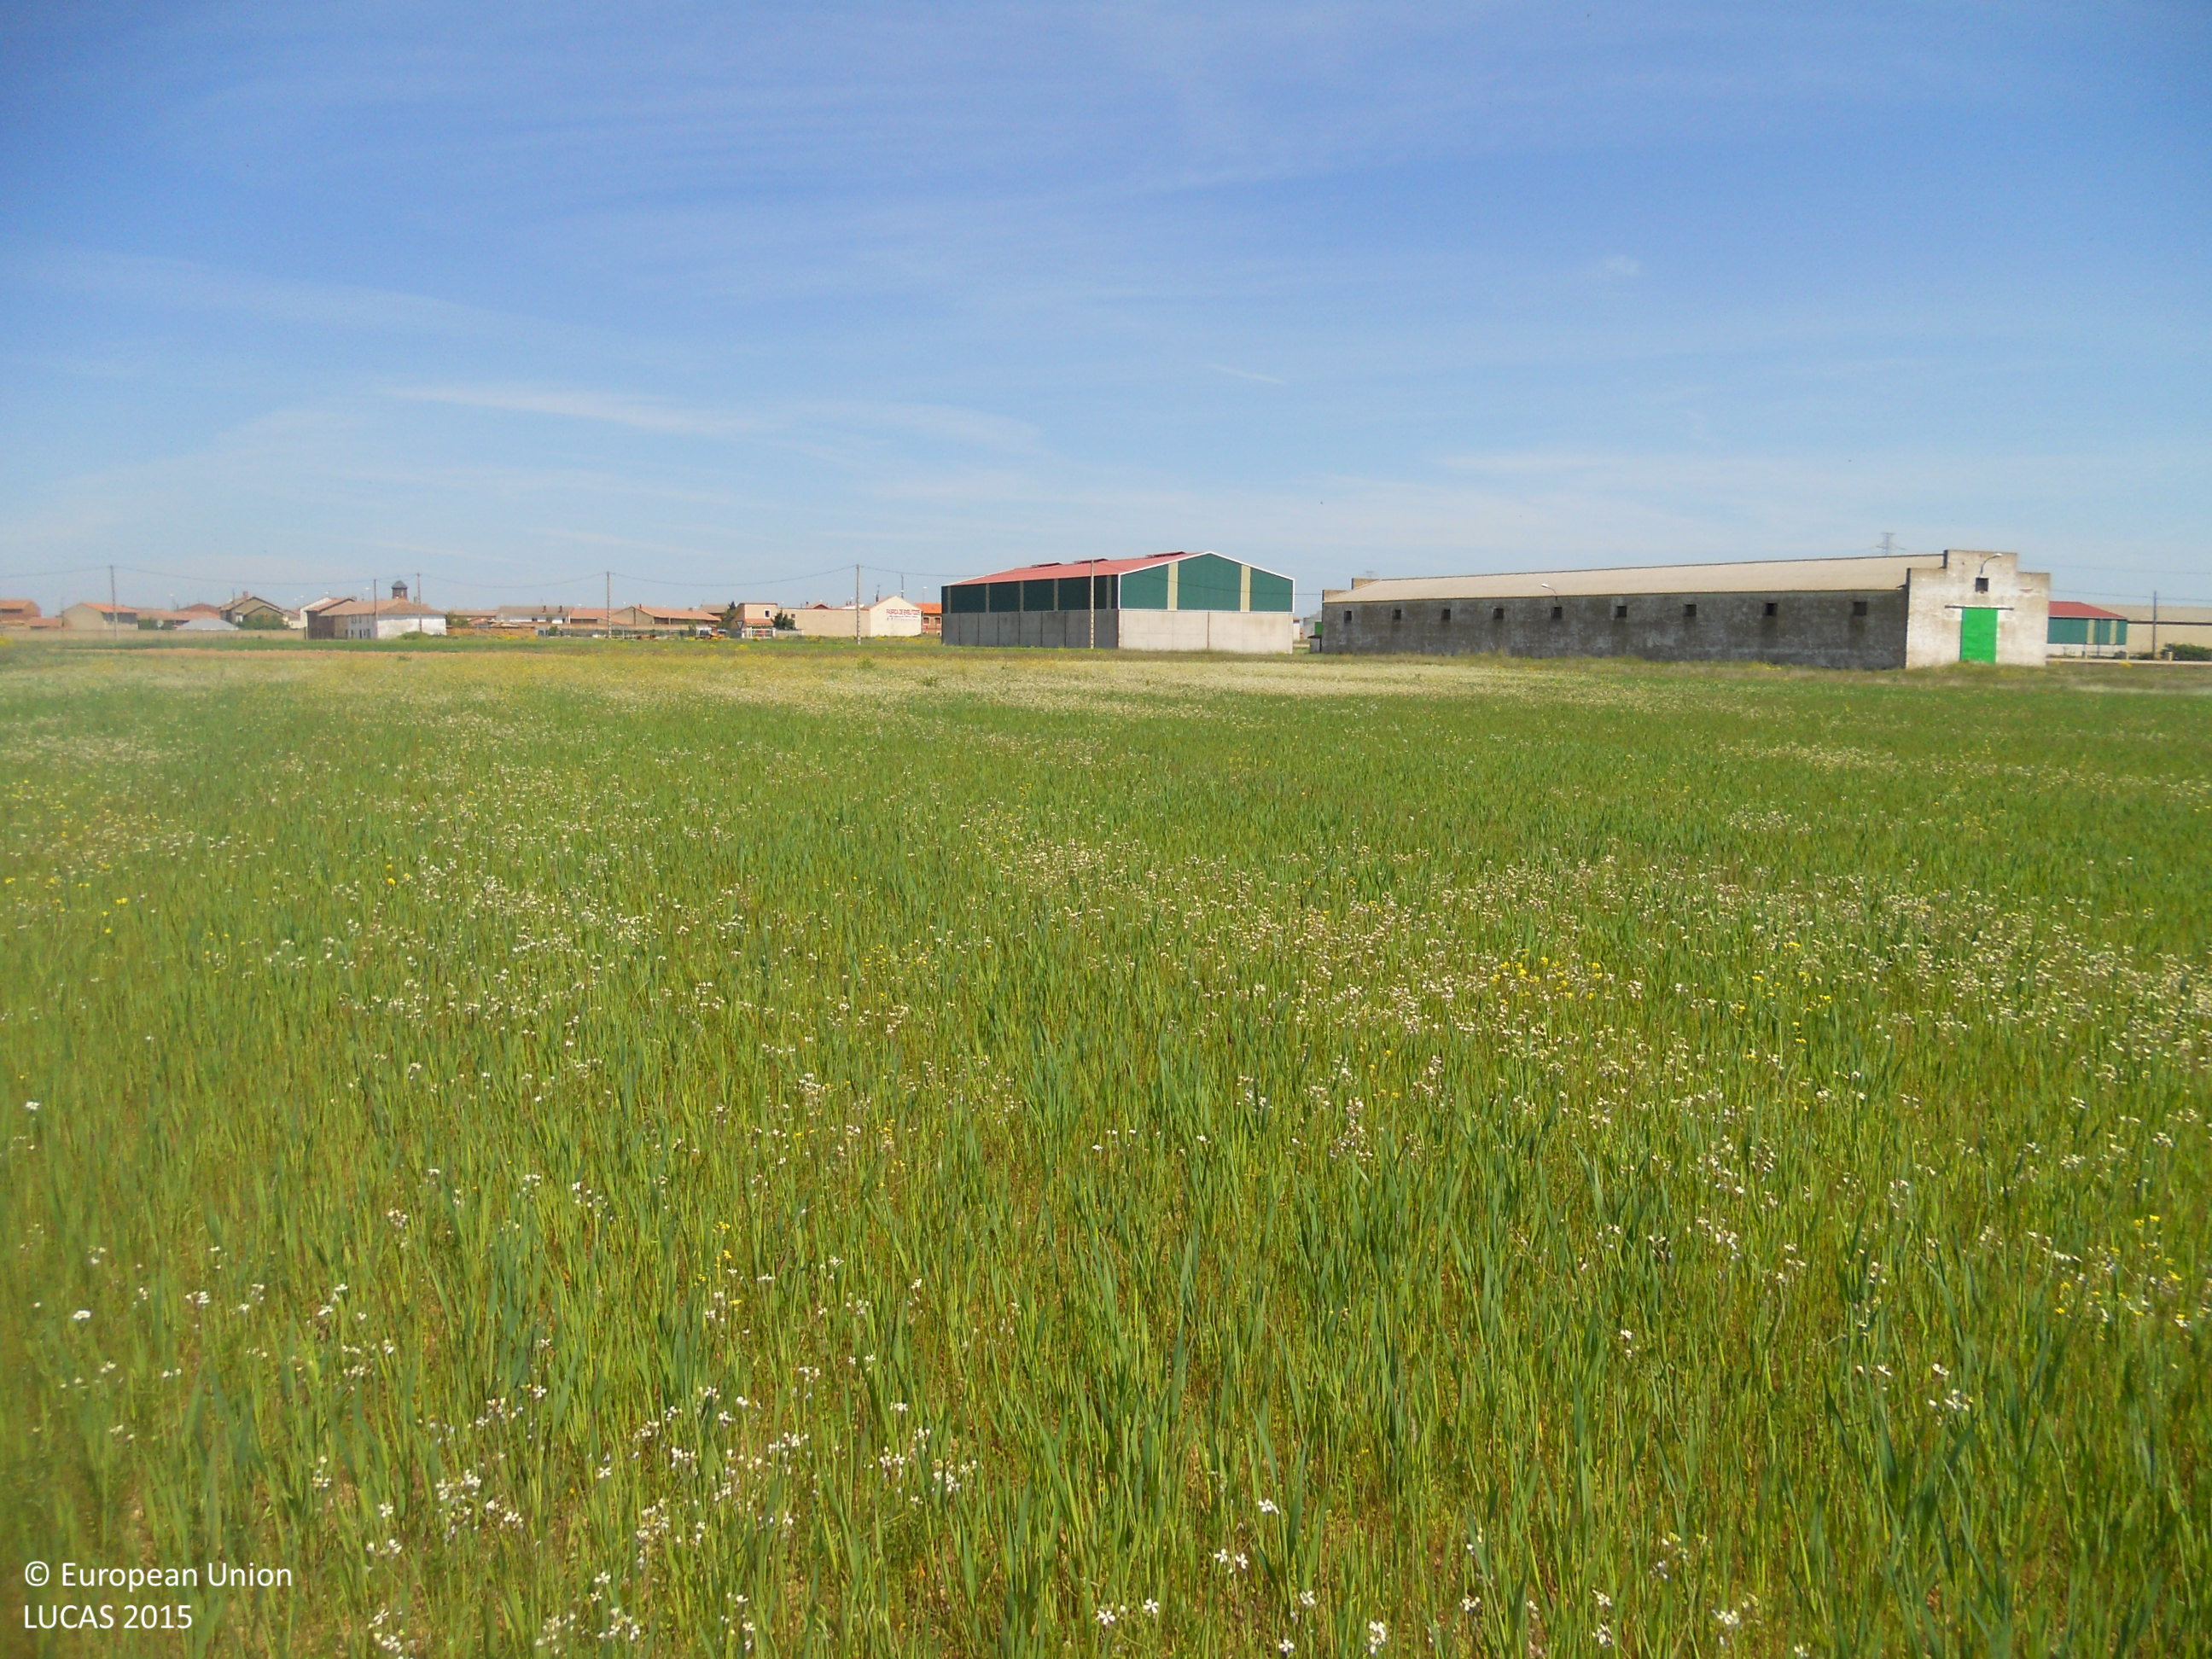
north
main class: Cropland
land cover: Oats
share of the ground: > 75 %
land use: Agriculture (excluding fallow land and kitchen gardens)
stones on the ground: 10 - 25 %
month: May
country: ES
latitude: 42.4271
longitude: -5.3690
